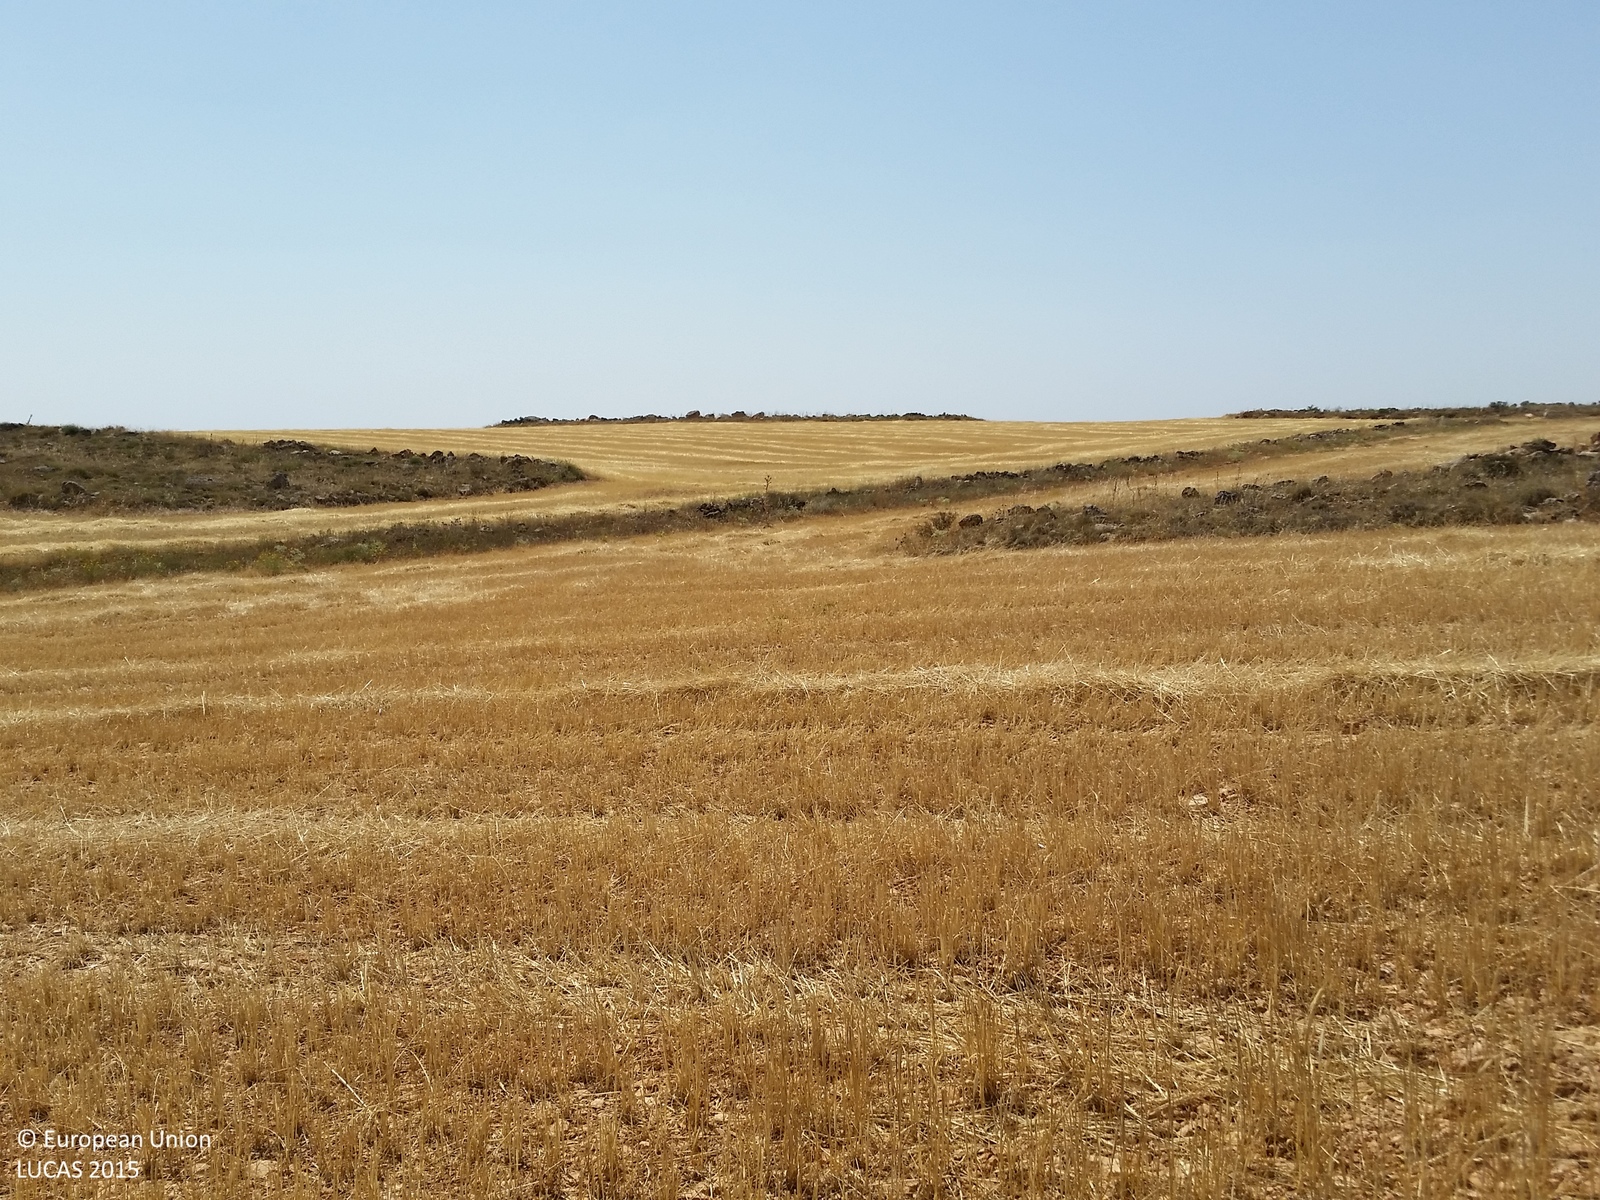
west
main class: Cropland
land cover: Common wheat
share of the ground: < 10 %
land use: Agriculture (excluding fallow land and kitchen gardens)
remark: Harvested field
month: July
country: ES
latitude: 38.8985
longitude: -2.4915
